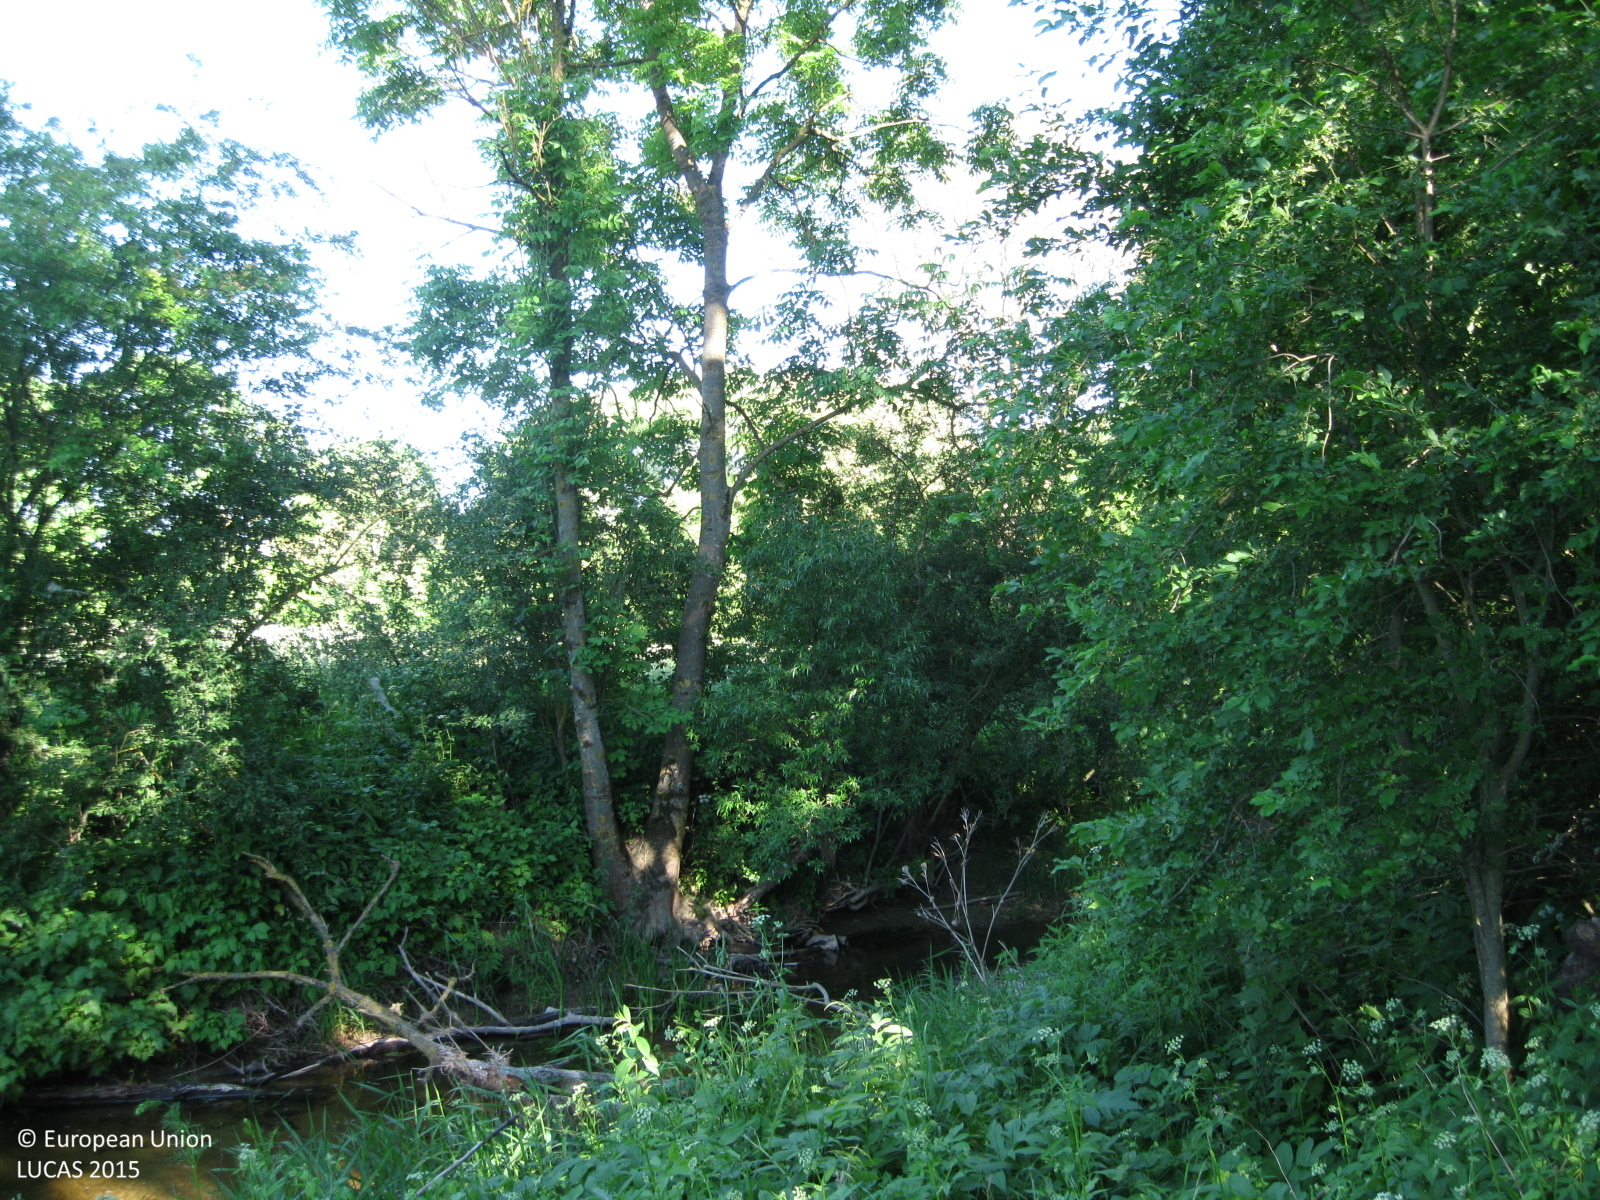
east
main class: Grassland
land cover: Spontaneously vegetated surfaces
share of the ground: > 75 %
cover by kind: herbaceous plants 100 %
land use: Semi-natural and natural areas not in use
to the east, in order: Spontaneously vegetated surfaces; Inland fresh running water; Broadleaved woodland; Spontaneously vegetated surfaces; Broadleaved woodland; Spontaneously vegetated surfaces; Broadleaved woodland; Grassland without tree/shrub cover; Broadleaved woodland; Grassland without tree/shrub cover; Broadleaved woodland
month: June
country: LT
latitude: 55.6884
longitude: 24.0071
